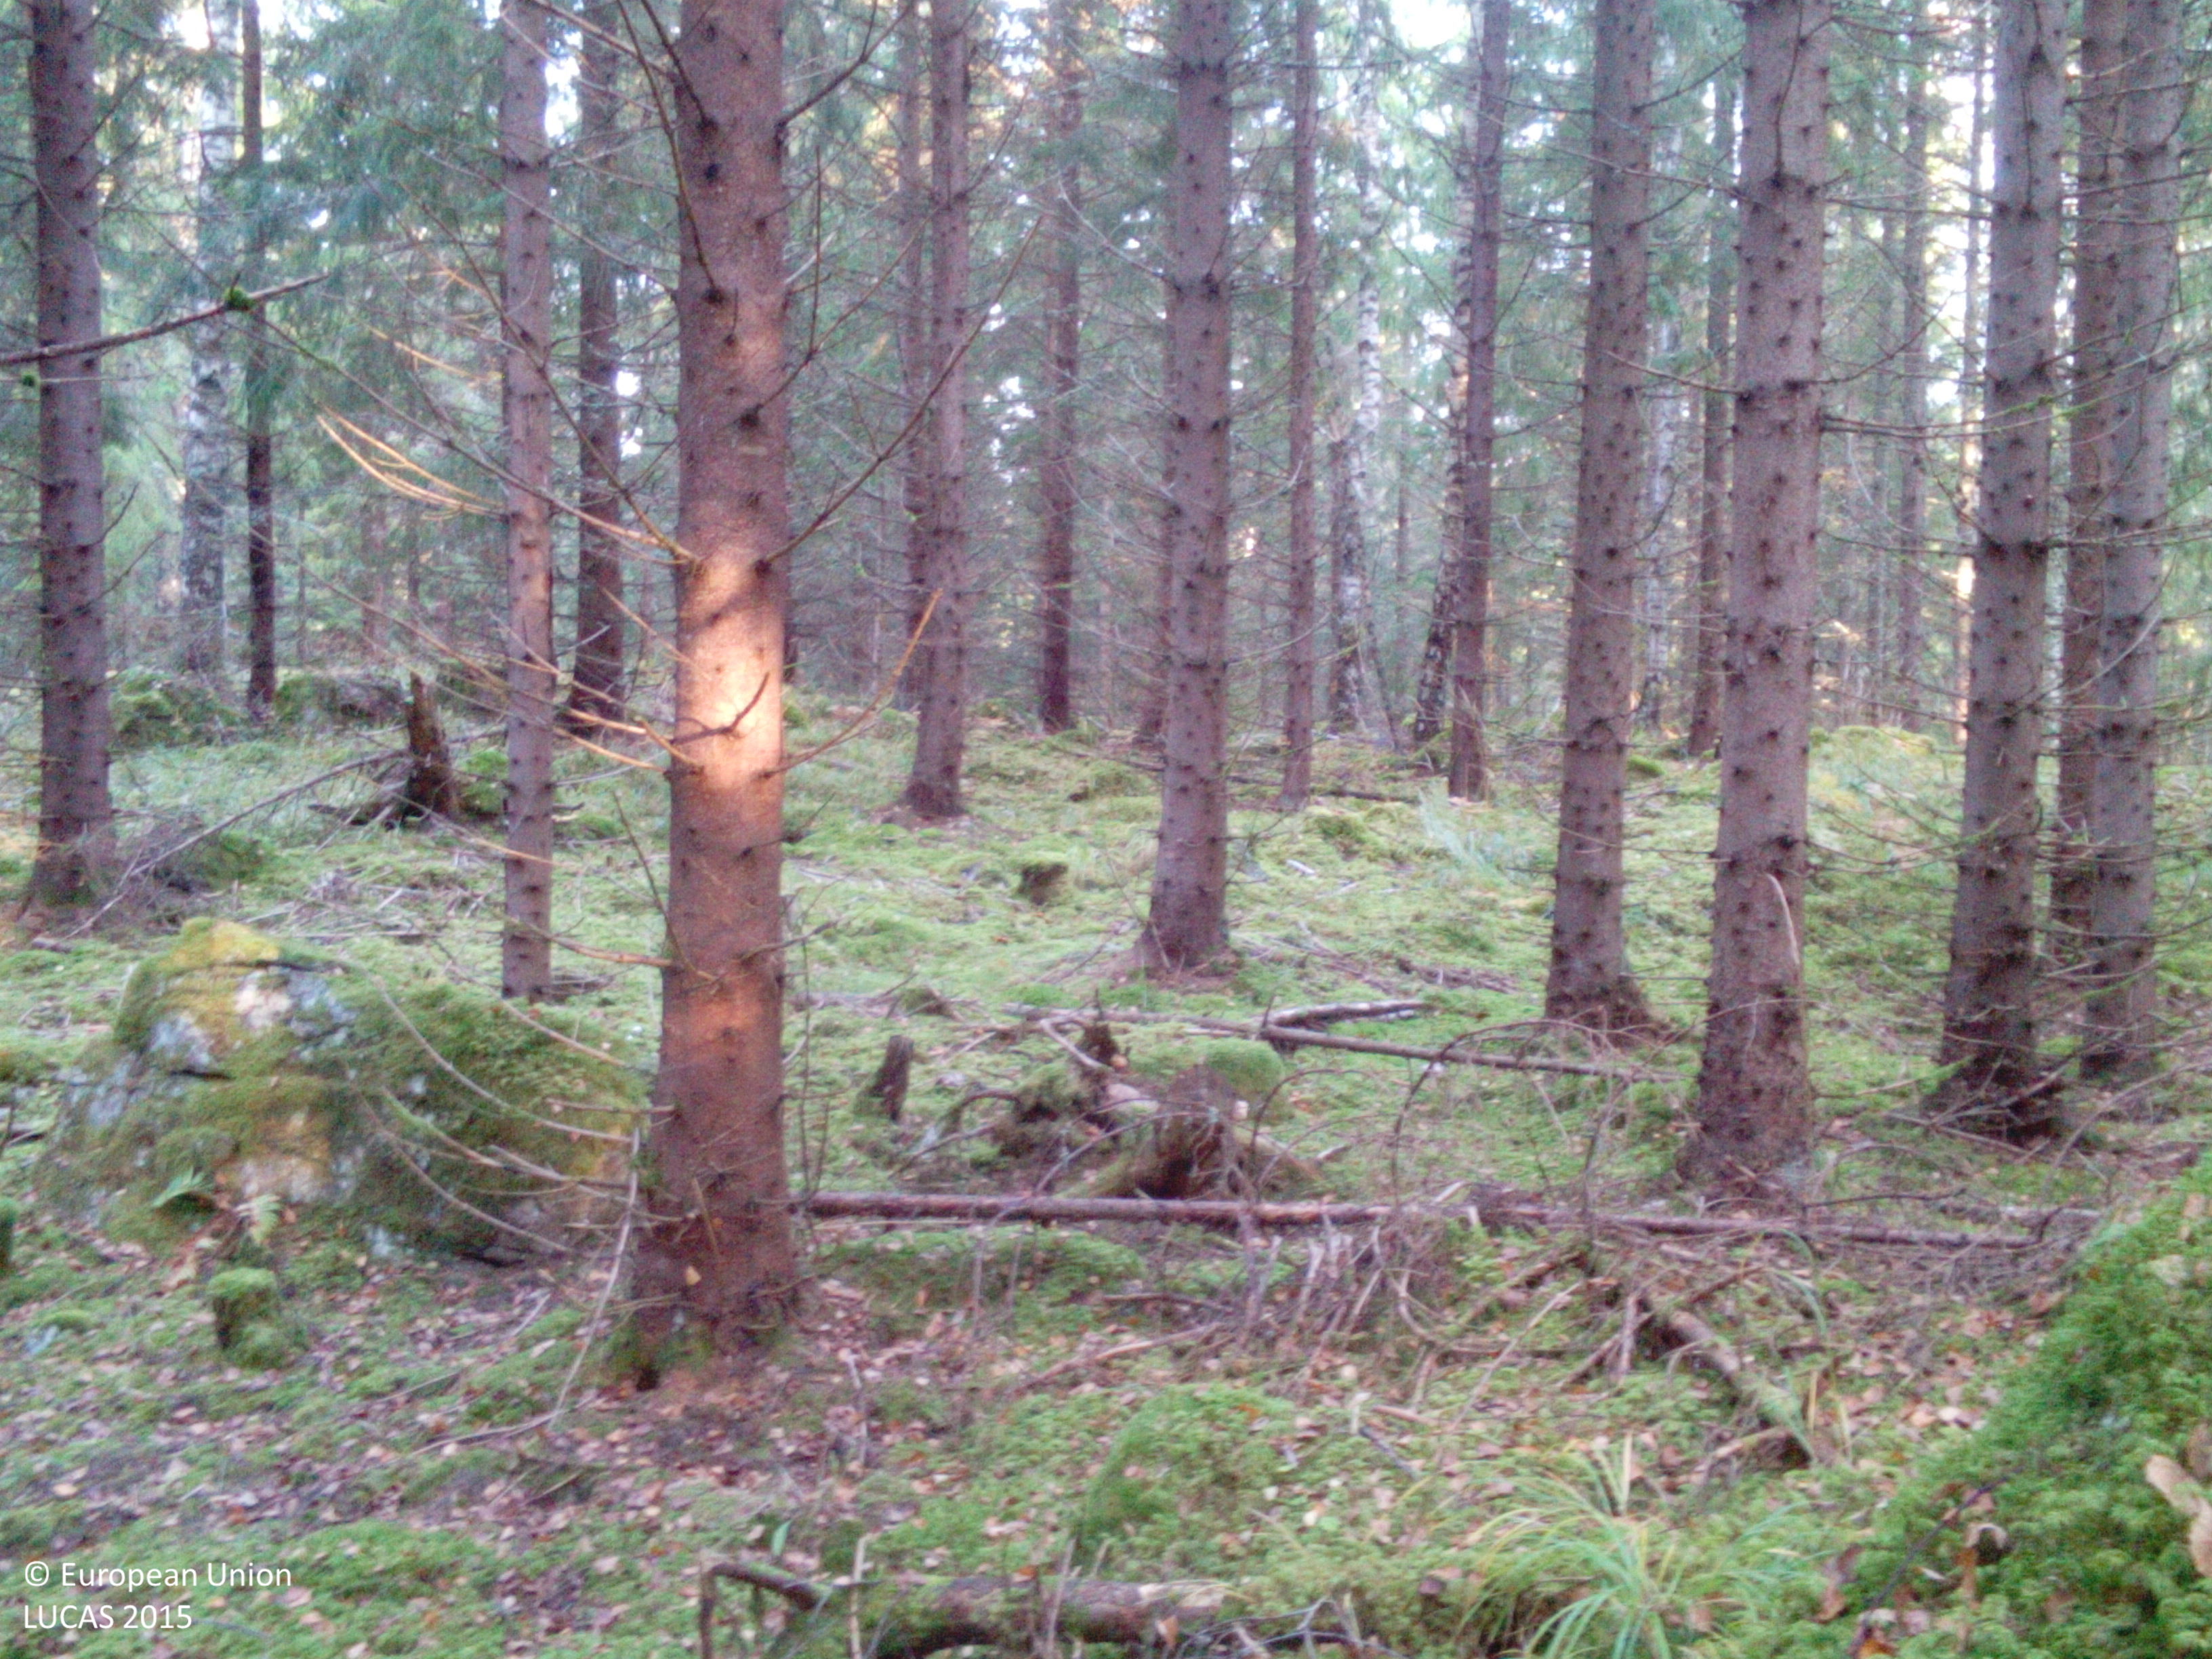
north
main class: Woodland
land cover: Spruce dominated mixed woodland
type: boreal forest
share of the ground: > 75 %
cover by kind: coniferous forest trees 65 %, broadleaved forest trees 25 %, lichens and mosses 10 %
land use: Forestry
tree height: > 5 m
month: October
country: SE
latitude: 58.8518
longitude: 16.2168
